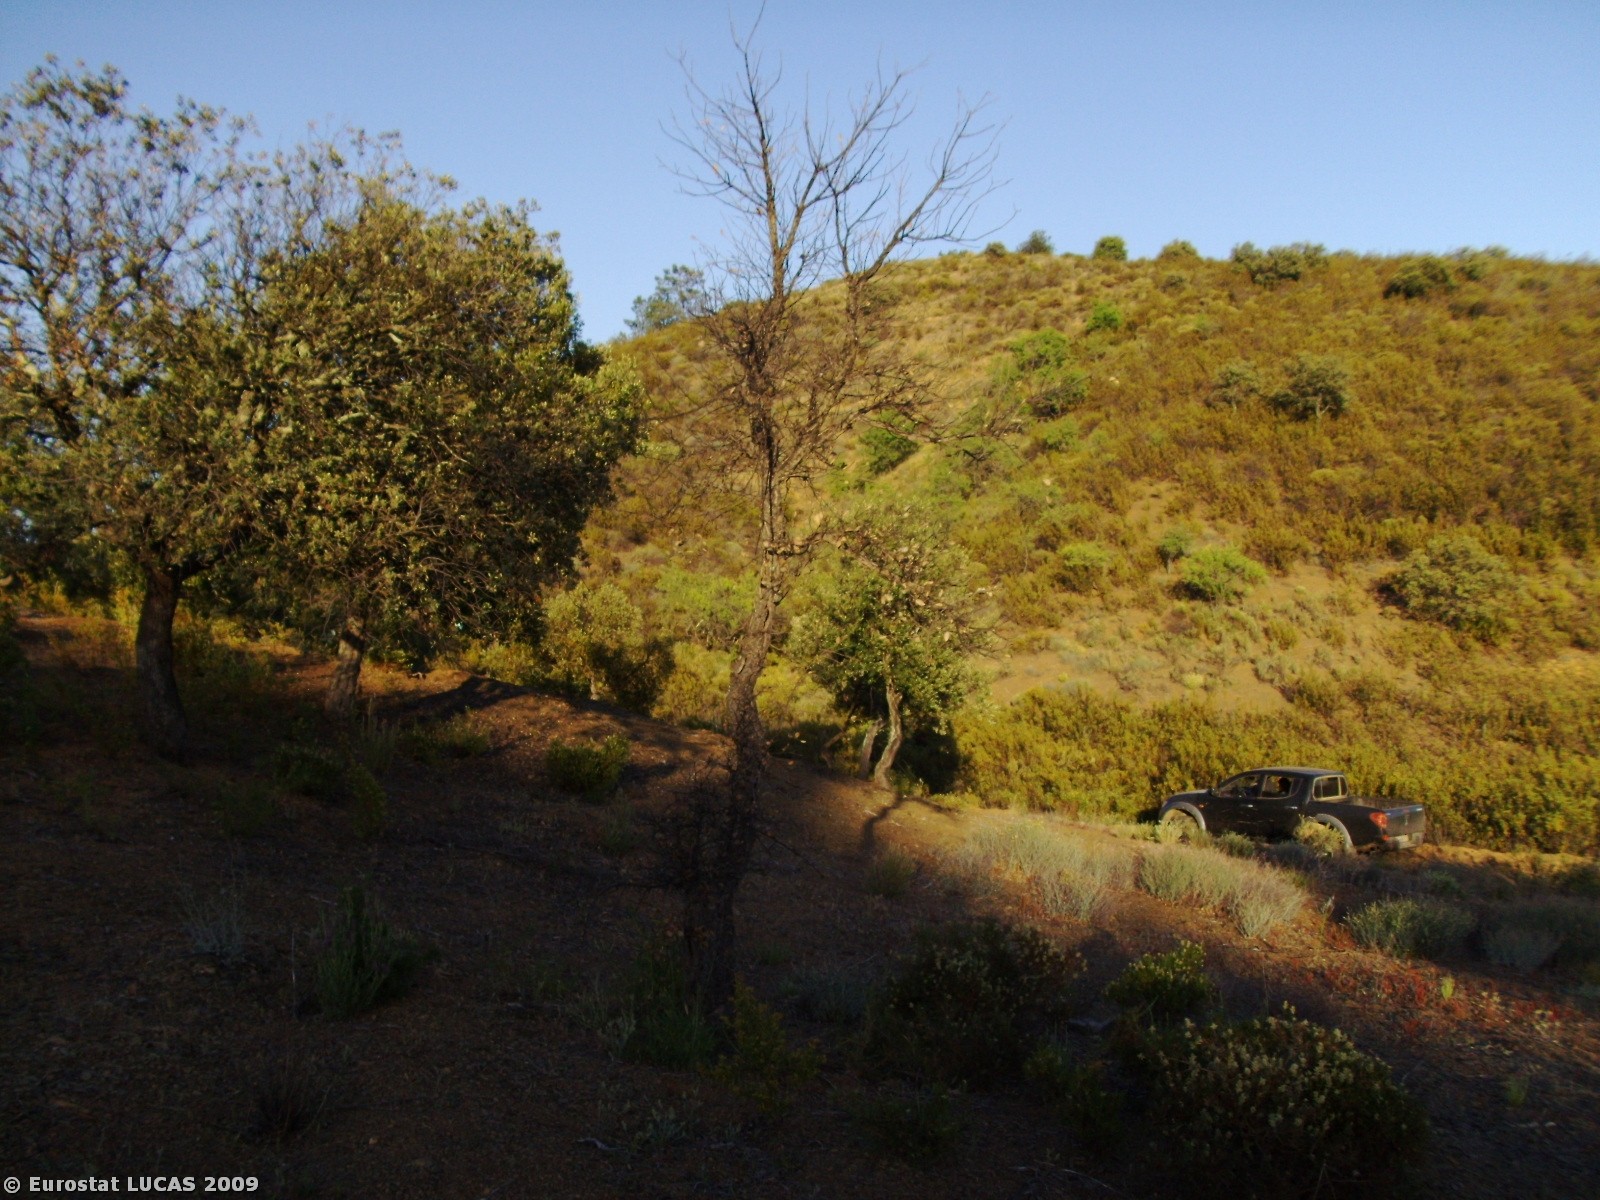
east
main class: Shrubland
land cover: Shrubland with sparse tree cover
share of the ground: < 10 %
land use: Forestry
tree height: > 5 m
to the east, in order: Shrubland with sparse tree cover; Broadleaved woodland; Bare land; Tracks; Durum wheat; Shrubland with sparse tree cover; Coniferous woodland
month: May
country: PT
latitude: 37.3568
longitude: -7.5636
